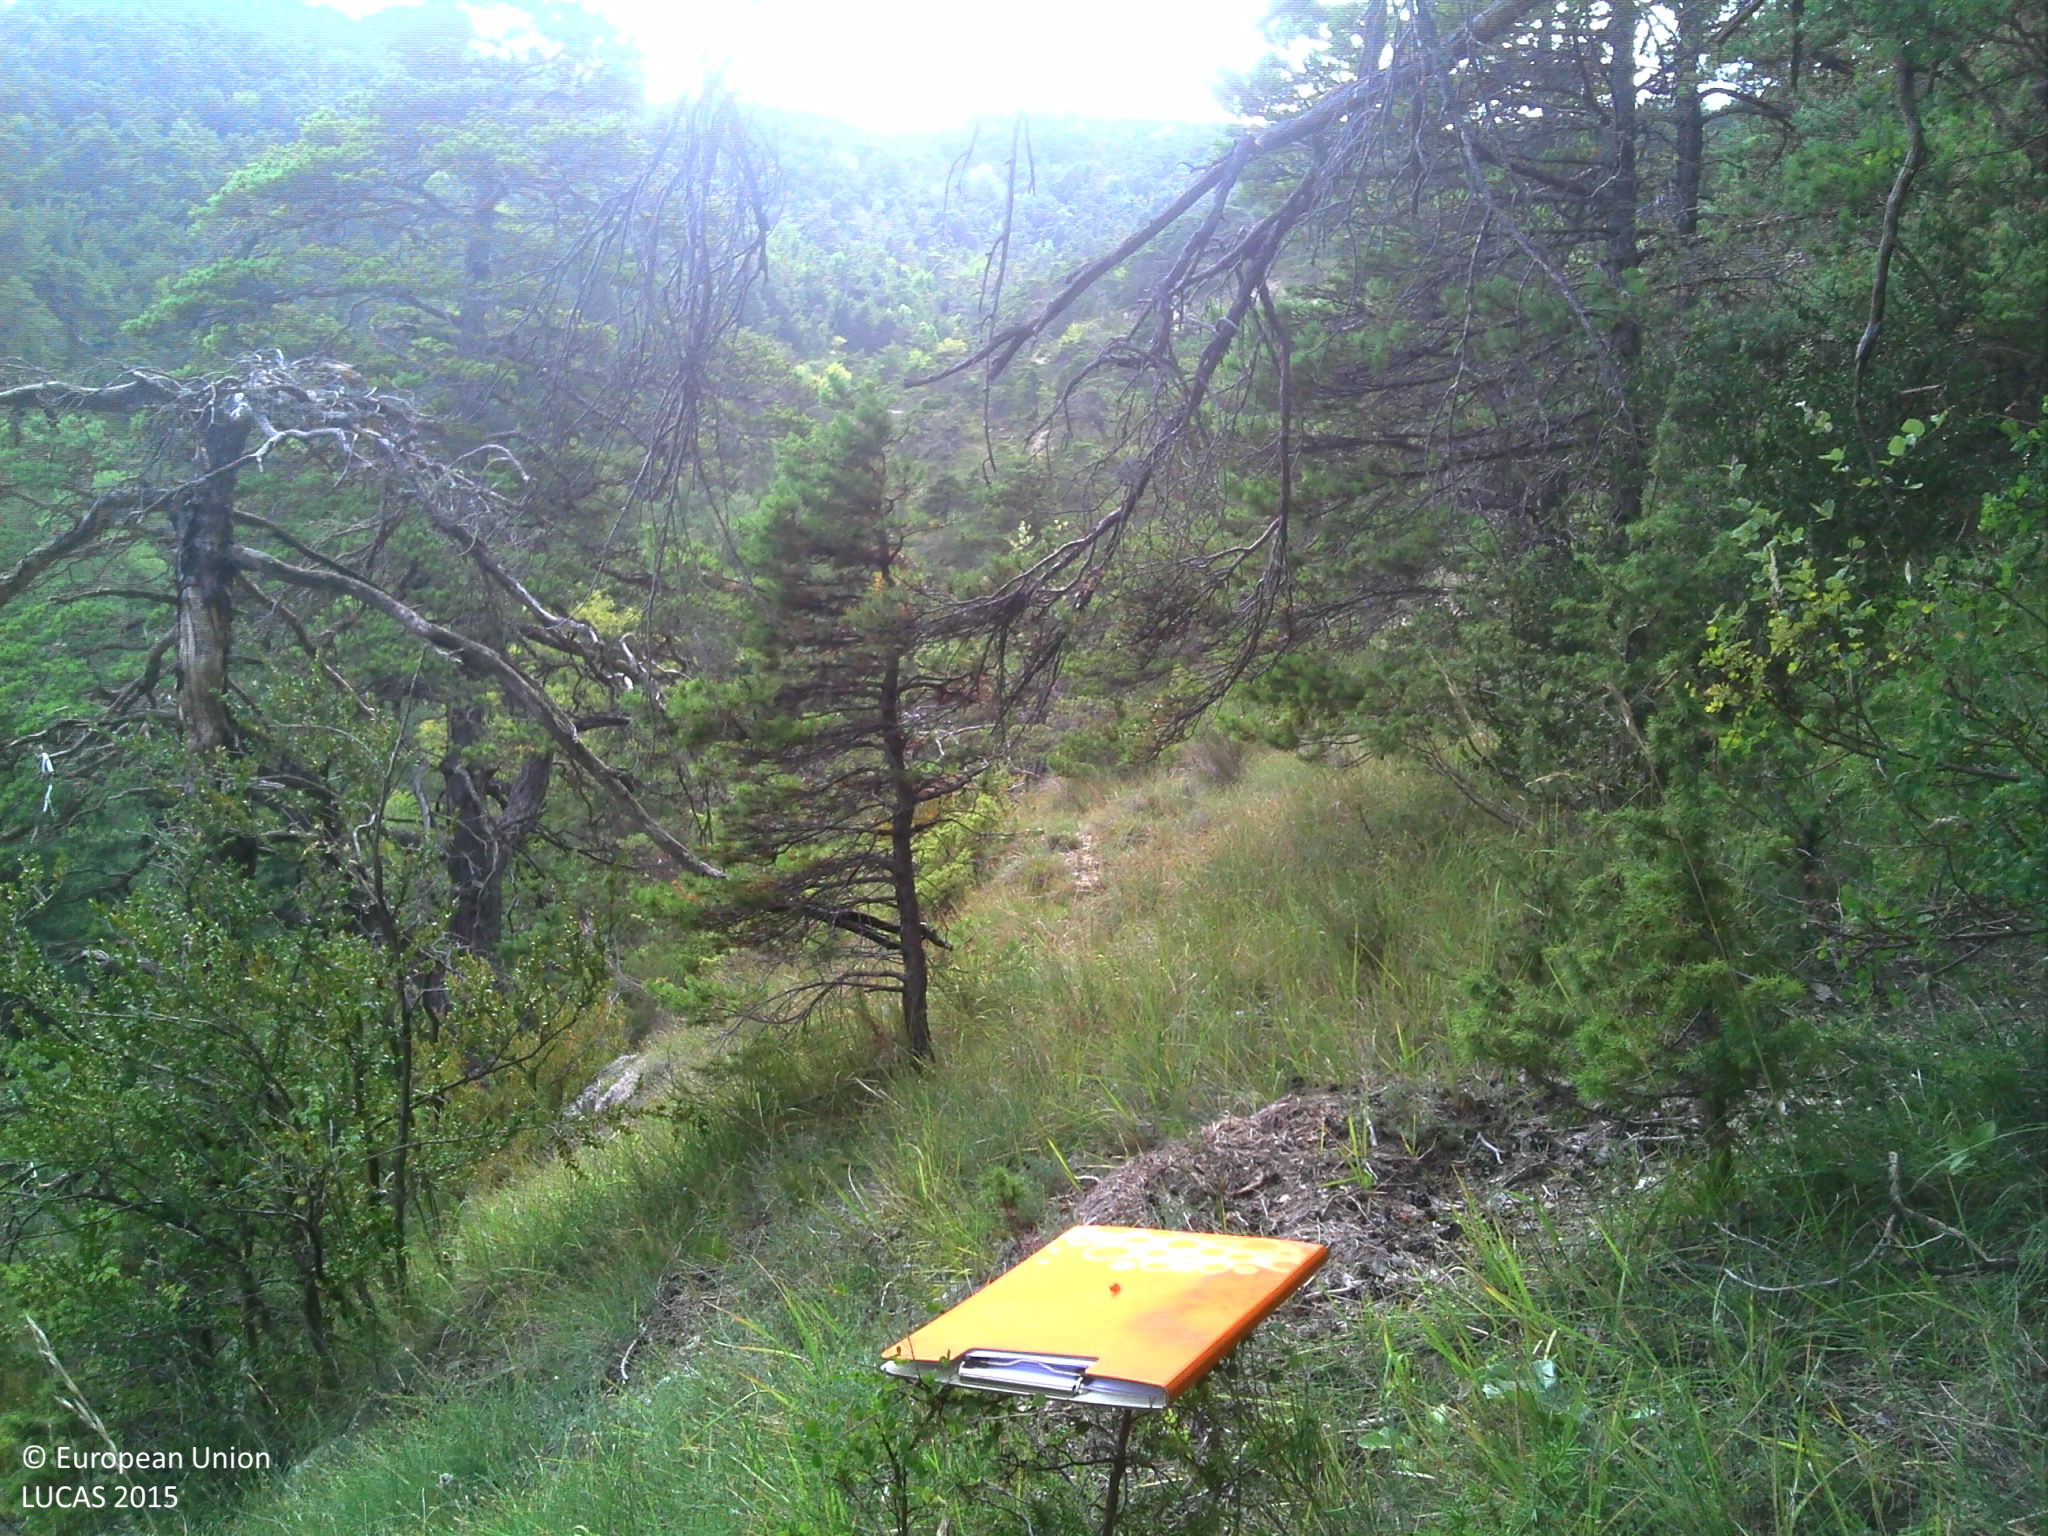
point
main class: Woodland
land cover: Pine dominated coniferous woodland
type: coniferous forest of the mediterranean region
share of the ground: > 75 %
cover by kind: coniferous forest trees 65 %, herbaceous plants 30 %, broadleaved forest trees 5 %
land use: Semi-natural and natural areas not in use
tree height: > 5 m
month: September
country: FR
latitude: 44.5382
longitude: 5.4133
